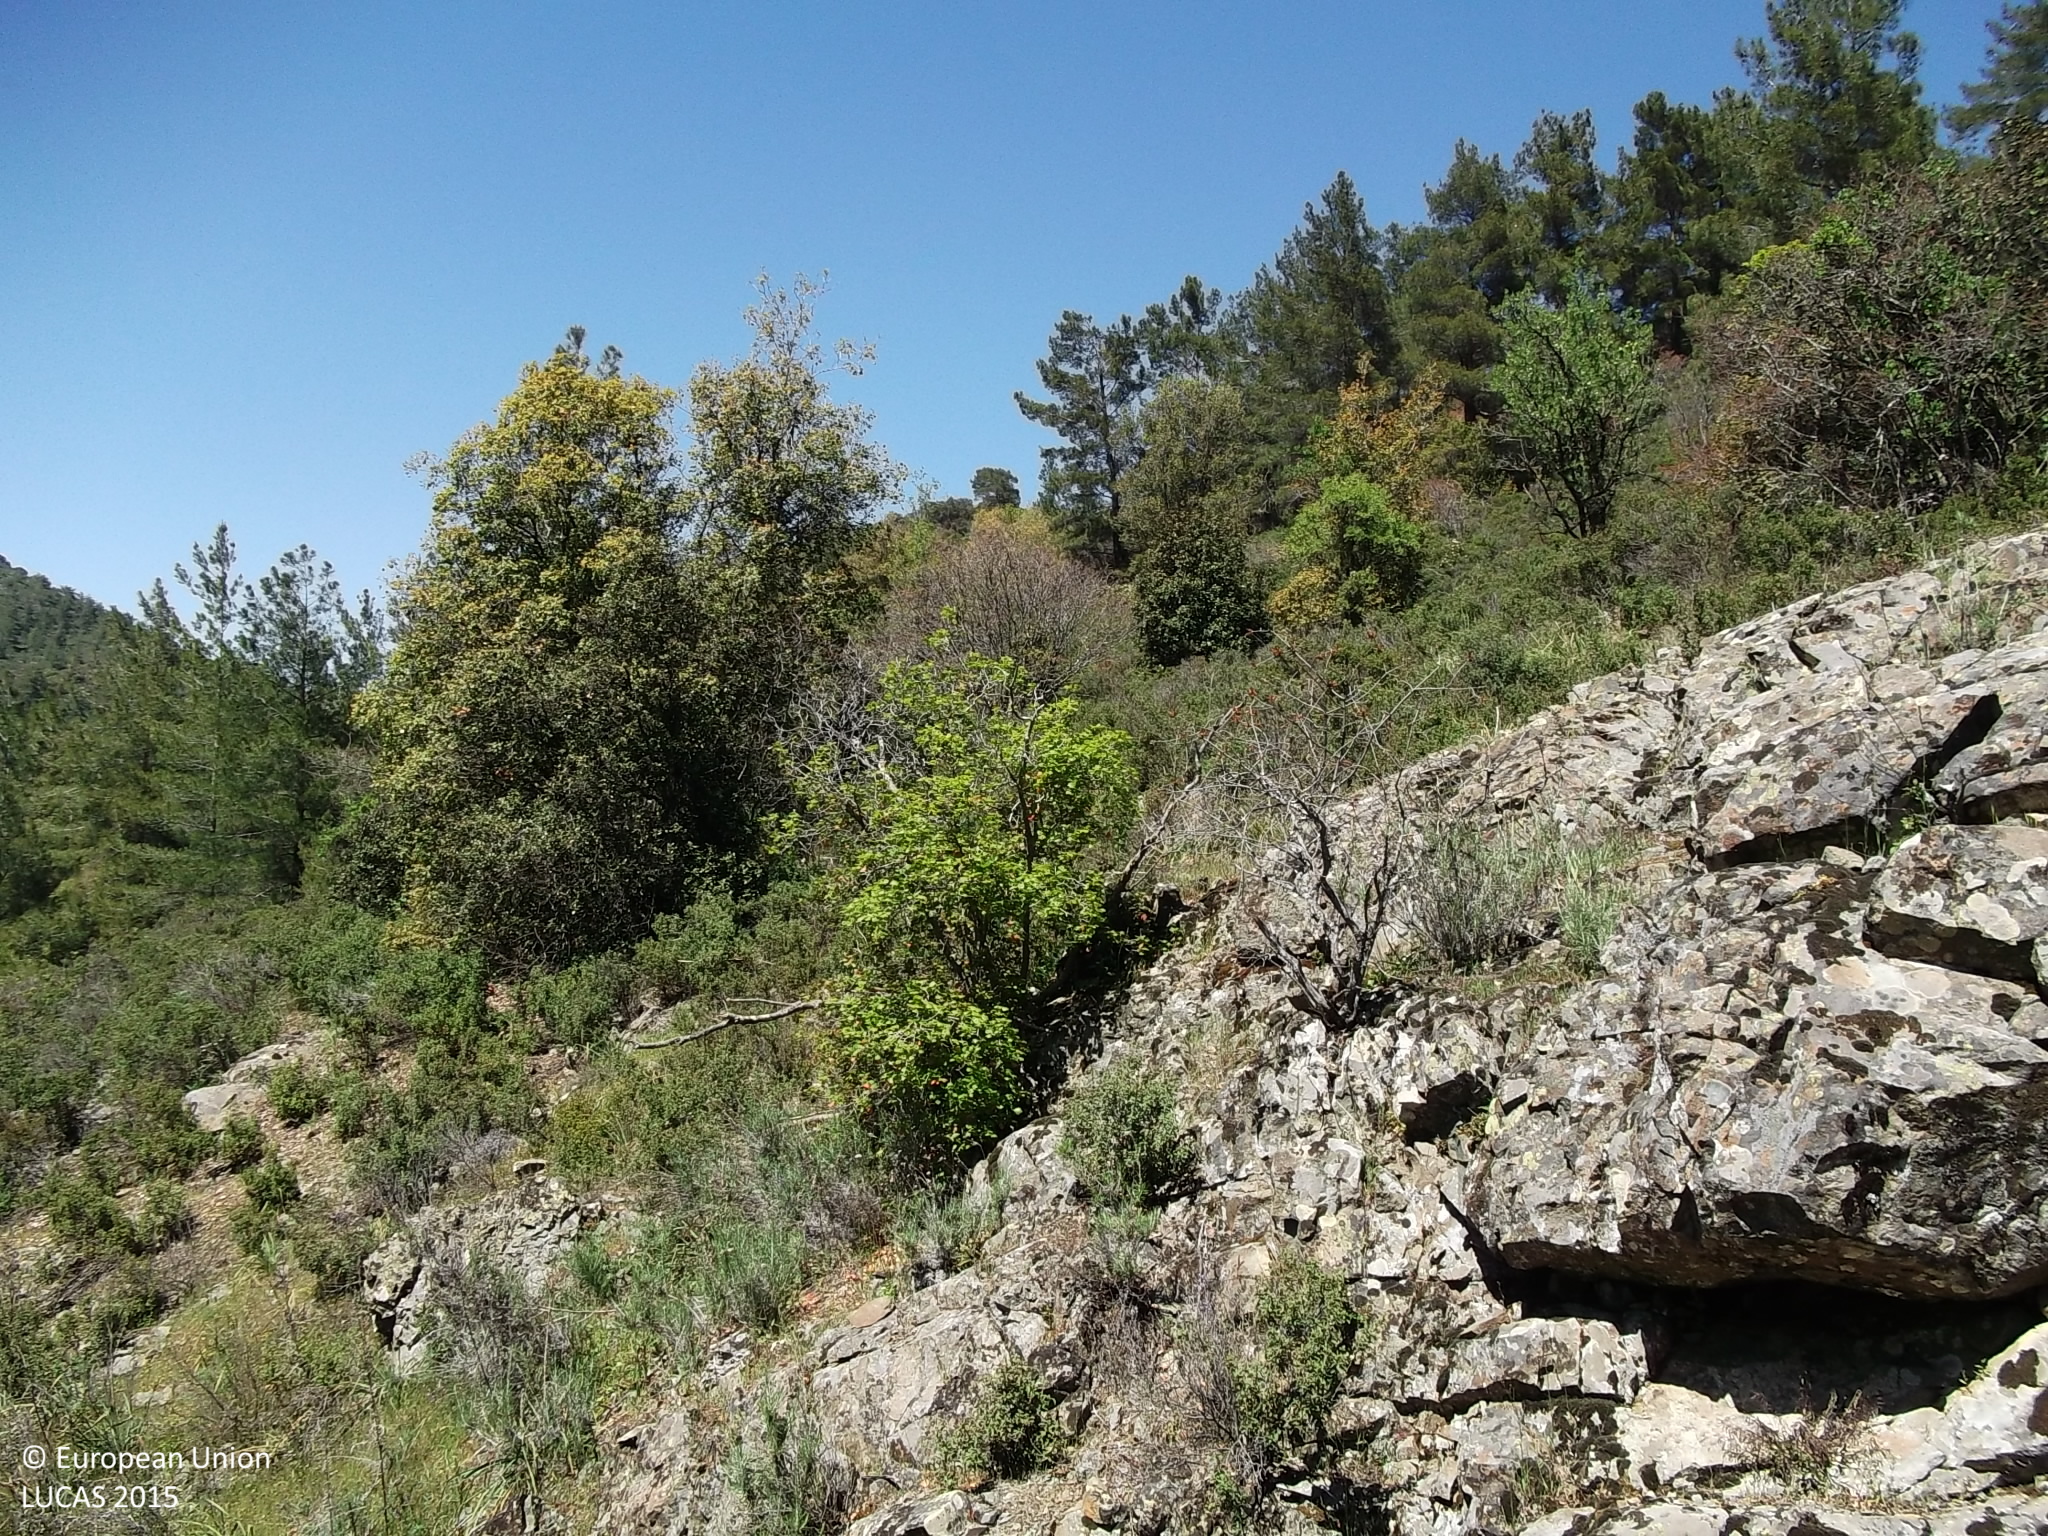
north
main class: Shrubland
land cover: Shrubland with sparse tree cover
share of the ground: > 75 %
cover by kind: shrubs 75 %, consolidated bare surface 10 %, unconsolidated bare surface 10 %, coniferous forest trees 5 %
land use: Semi-natural and natural areas not in use
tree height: > 5 m
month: April
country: CY
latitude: 34.9178
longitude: 33.1752
